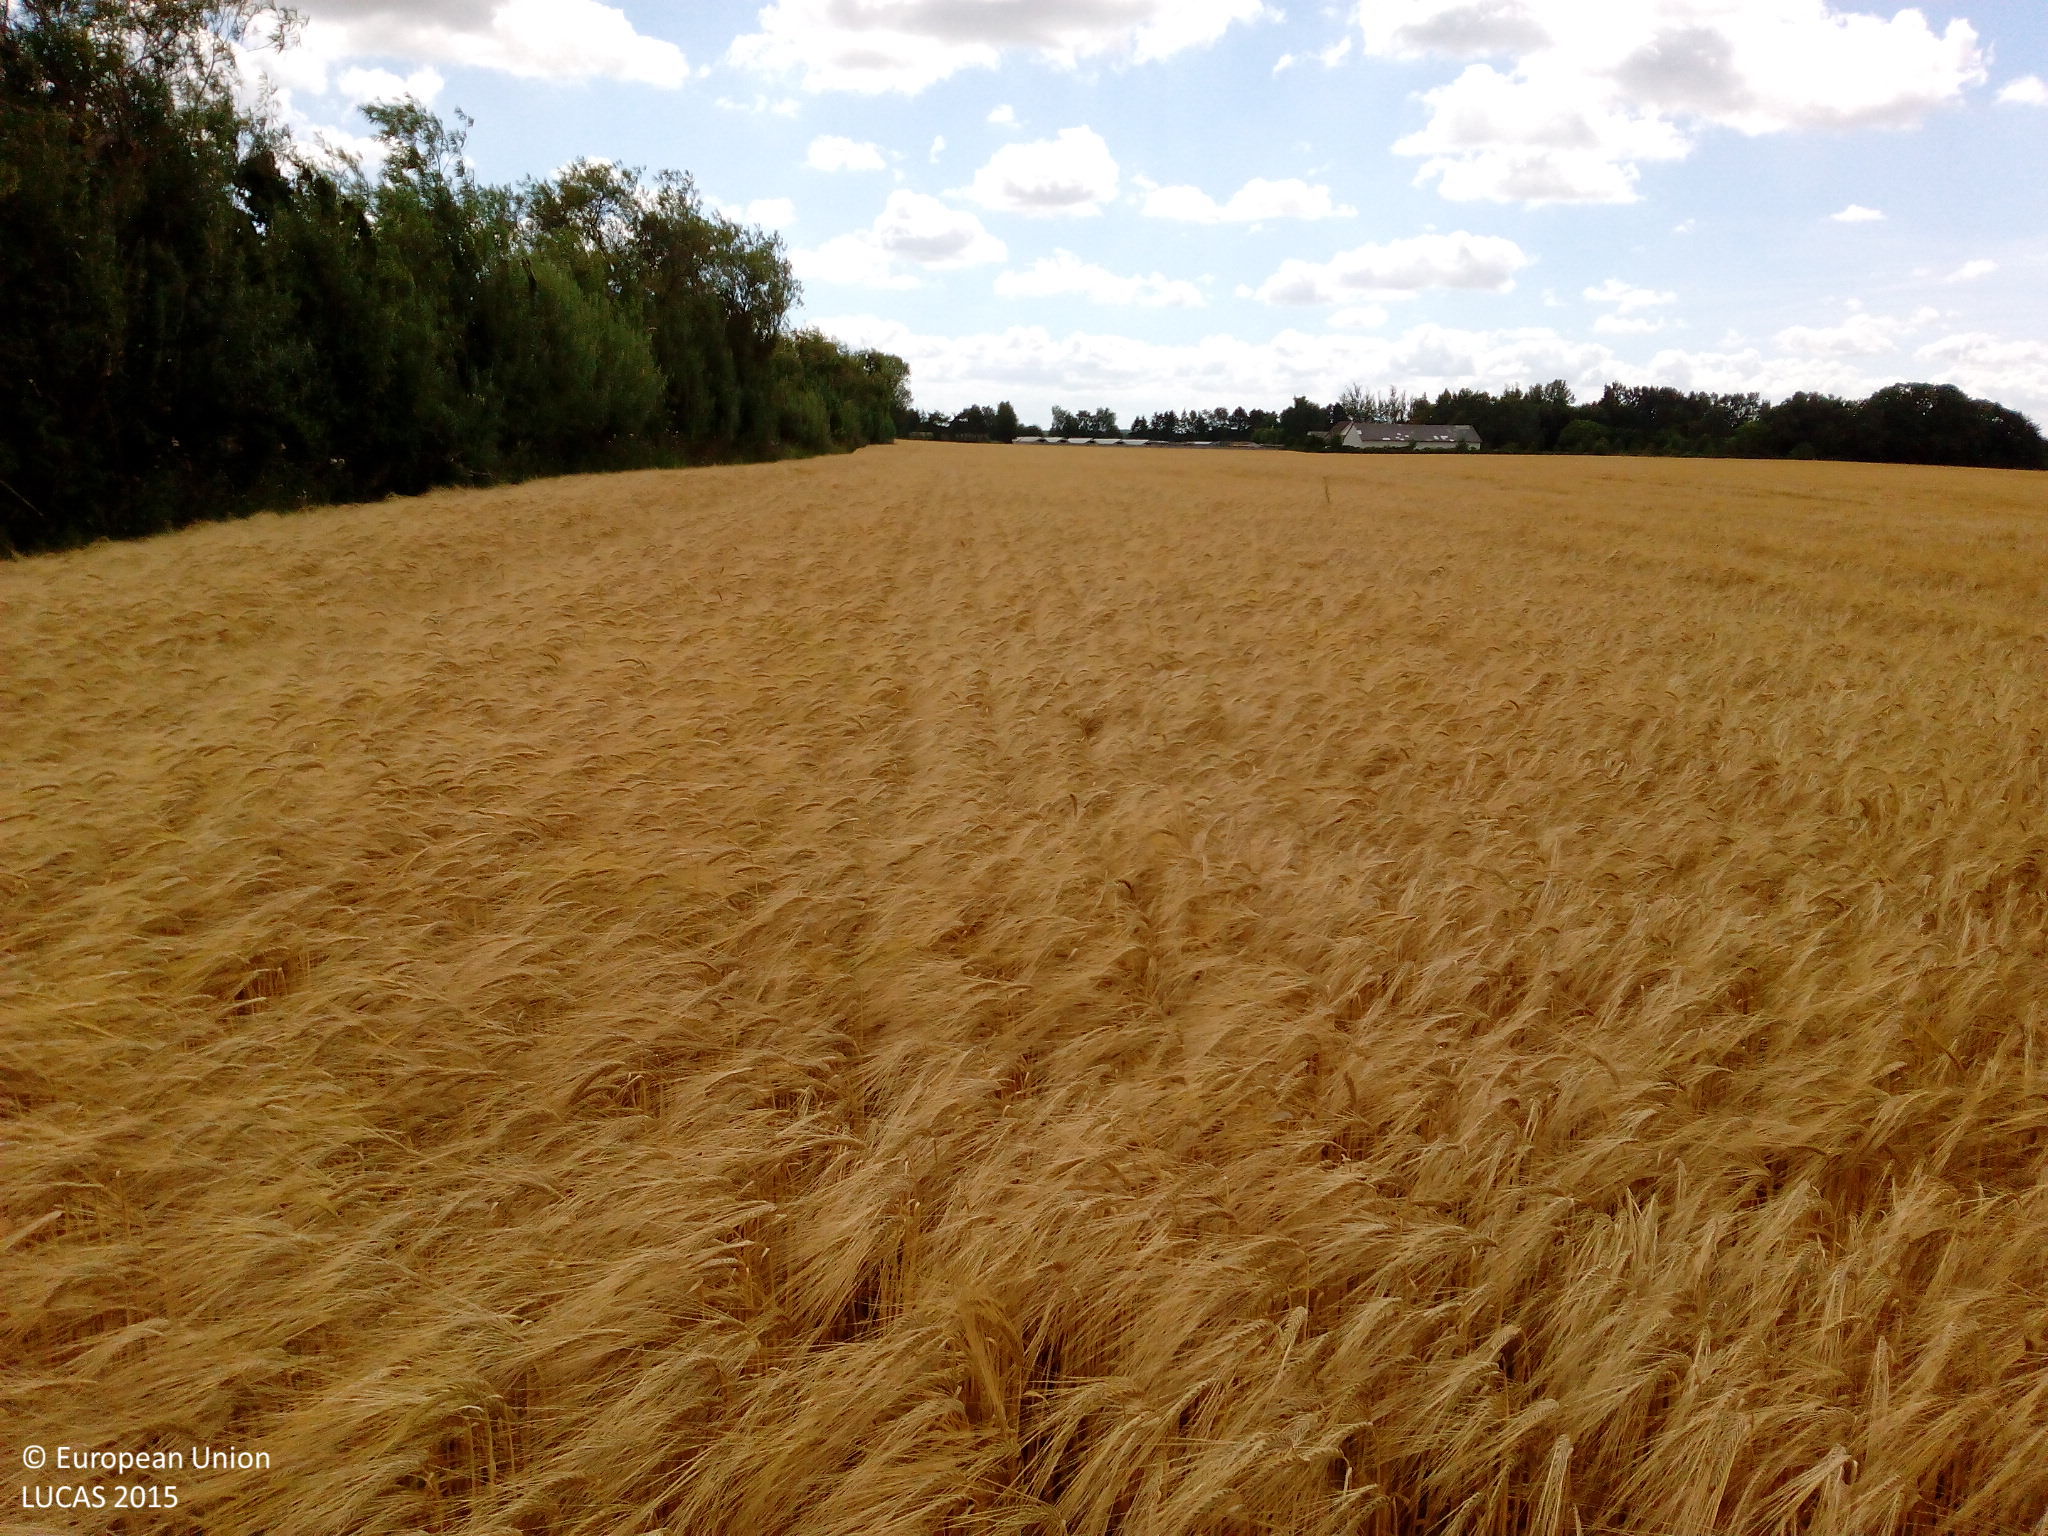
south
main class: Cropland
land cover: Barley
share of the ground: > 75 %
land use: Agriculture (excluding fallow land and kitchen gardens)
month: August
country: DK
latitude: 55.3419
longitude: 12.1901
